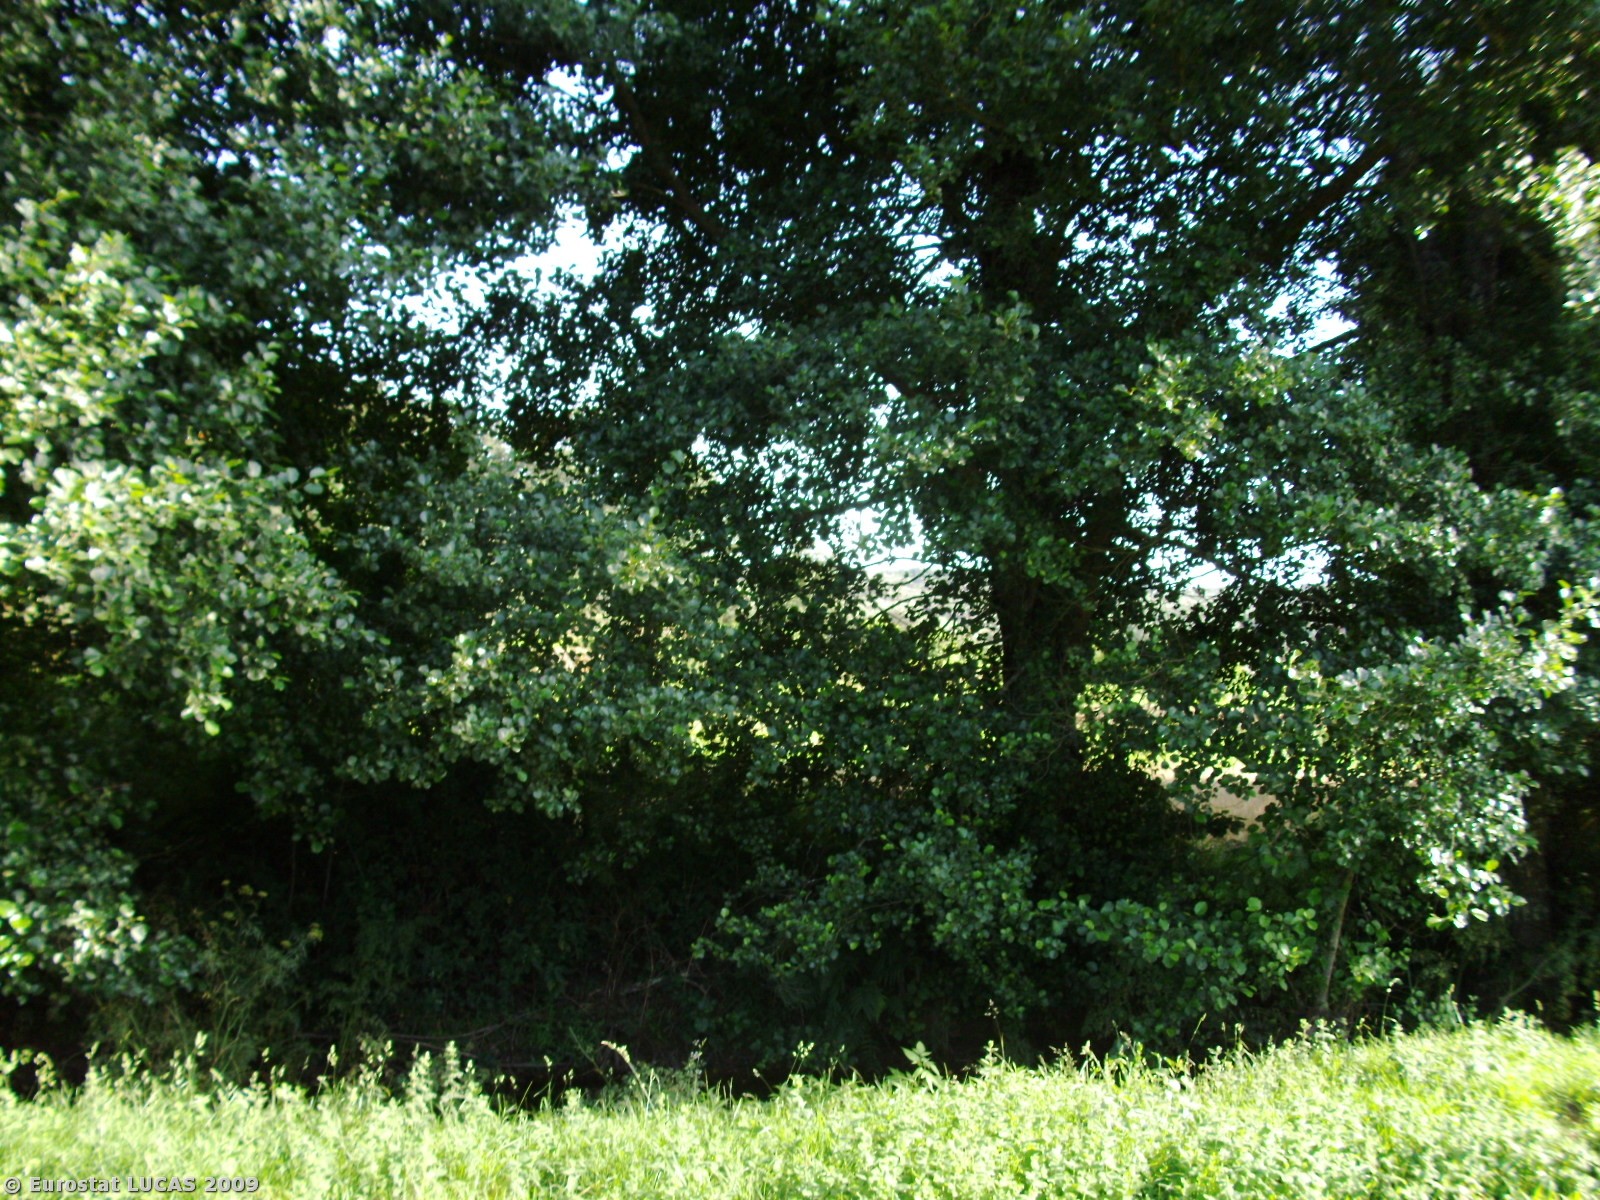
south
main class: Cropland
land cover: Maize
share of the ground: > 75 %
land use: Agriculture (excluding fallow land and kitchen gardens)
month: July
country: PT
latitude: 40.6108
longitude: -7.6445
